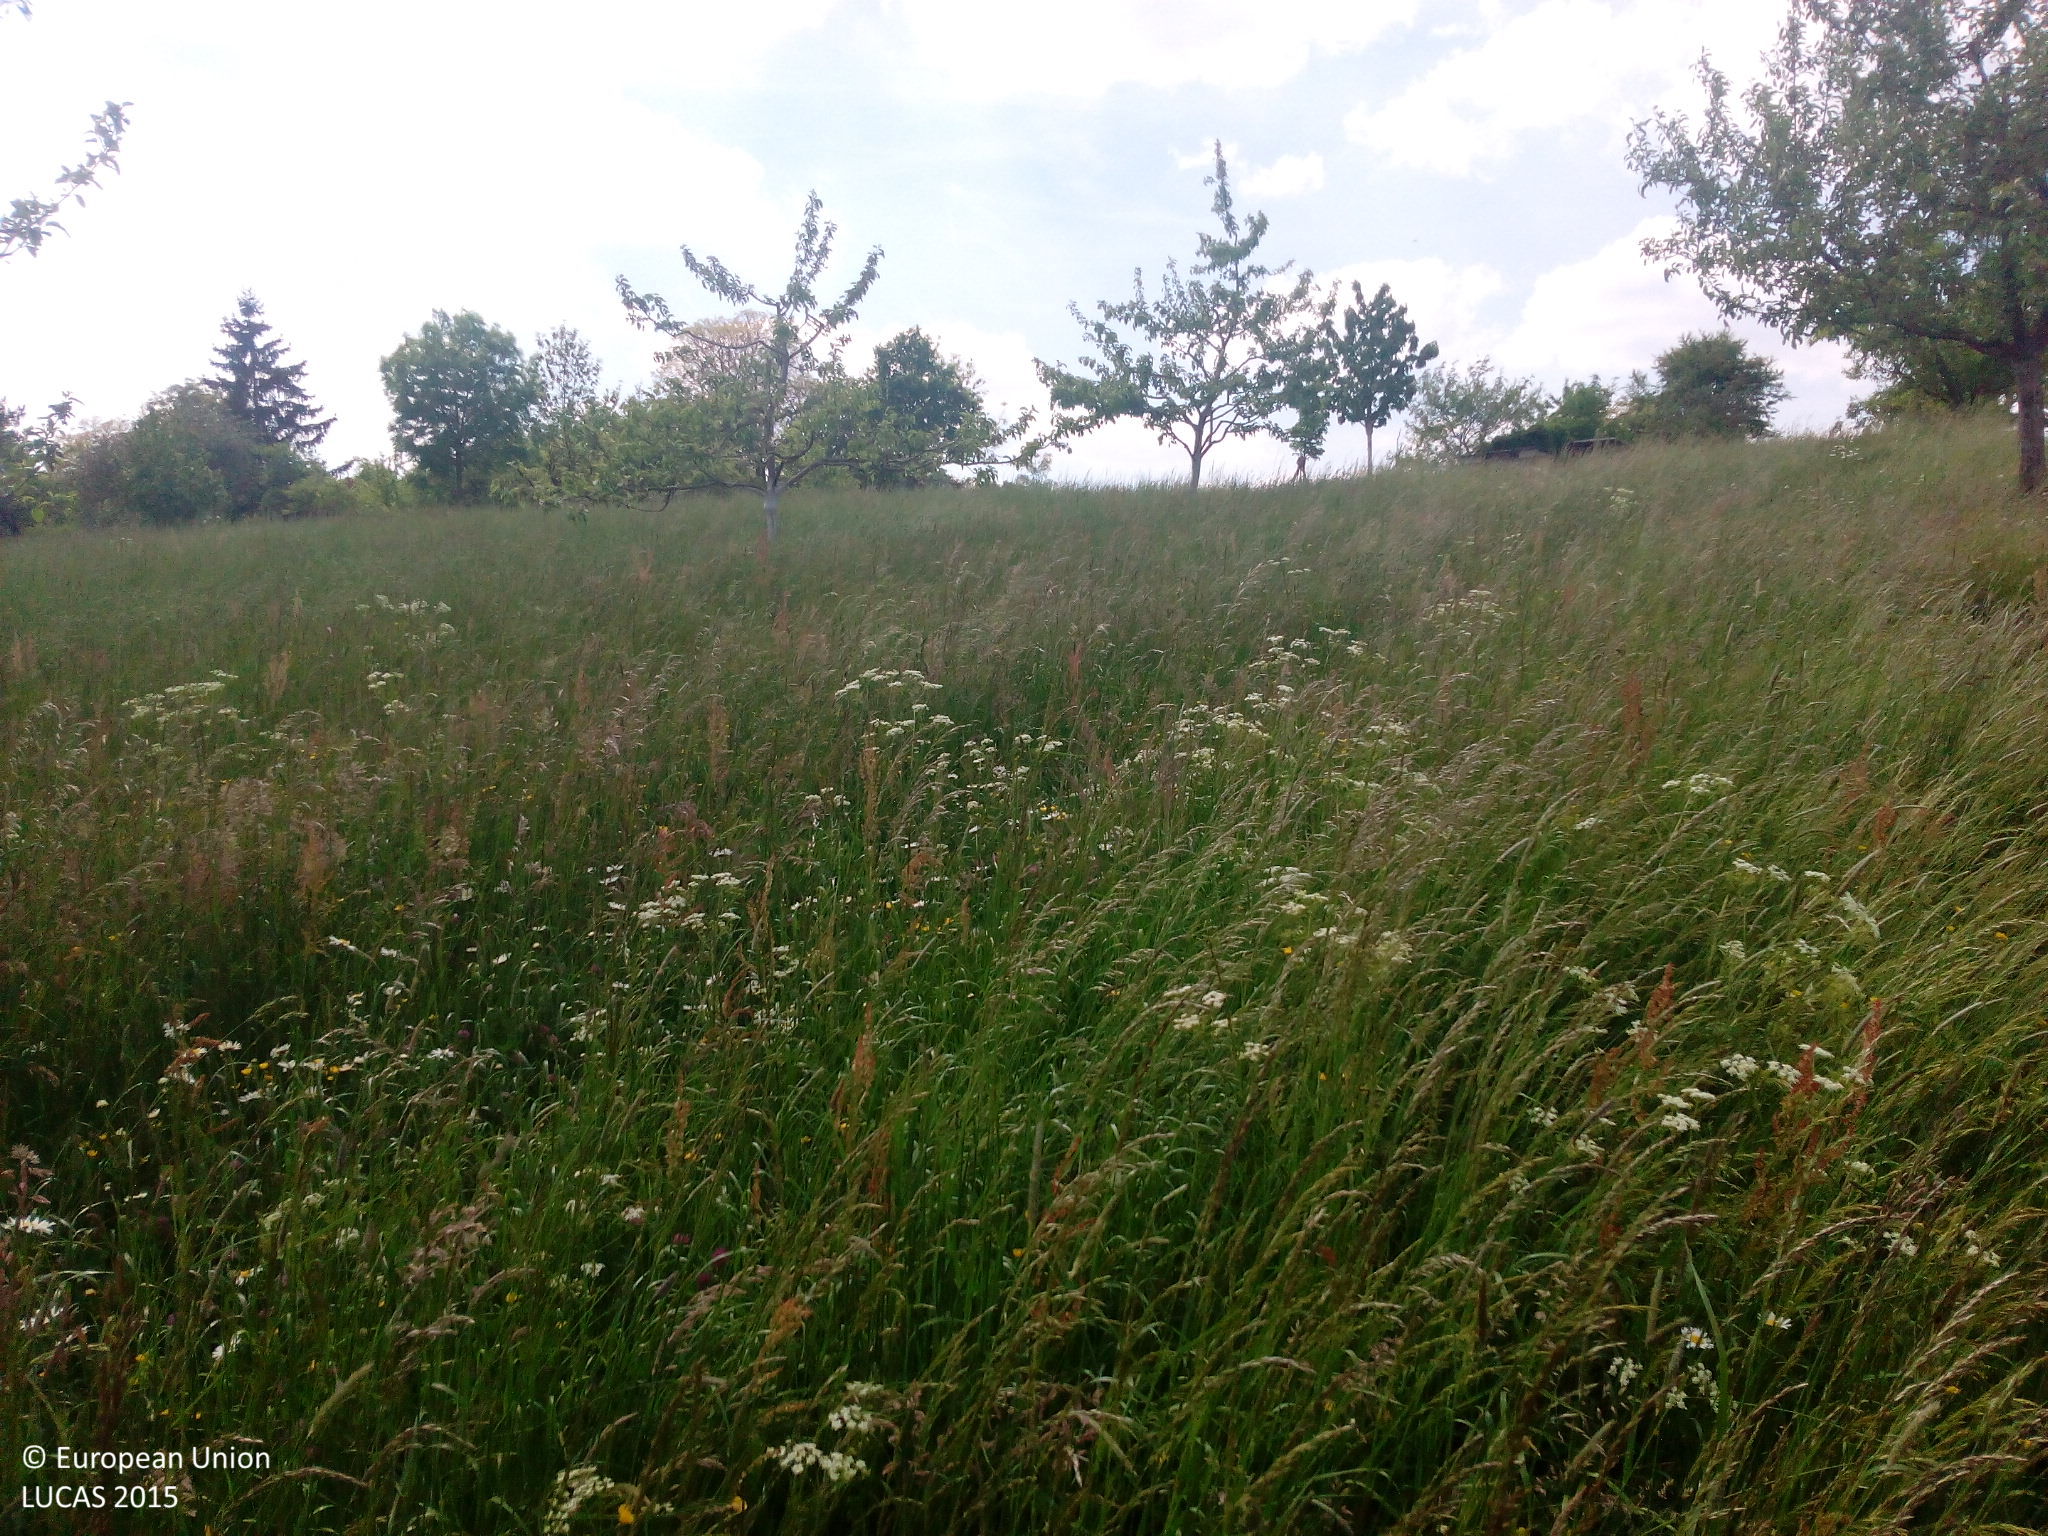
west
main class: Cropland
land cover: Apple fruit
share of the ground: 10 - 25 %
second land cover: Grassland without tree/shrub cover
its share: > 75 %
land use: Agriculture (excluding fallow land and kitchen gardens)
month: May
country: DE
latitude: 50.1804
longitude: 10.9380
